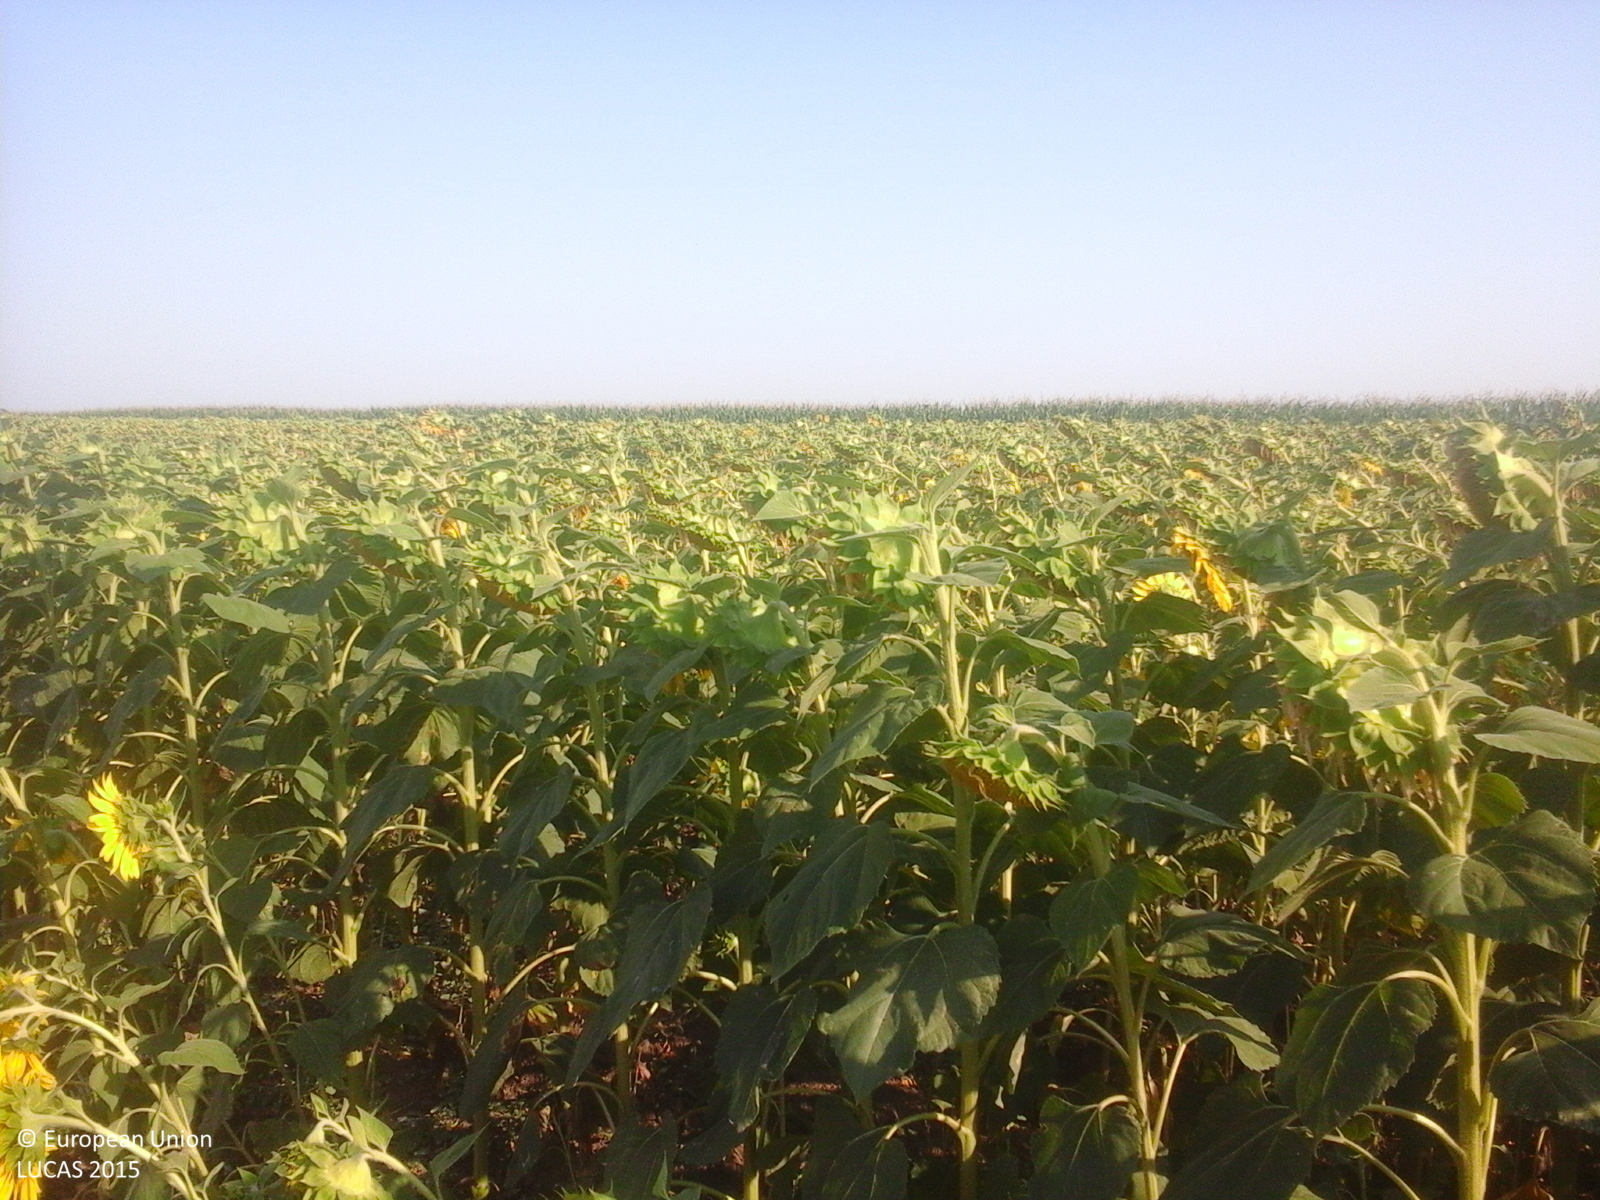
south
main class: Cropland
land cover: Sunflower
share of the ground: > 75 %
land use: Agriculture (excluding fallow land and kitchen gardens)
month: July
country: RO
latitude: 44.9461
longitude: 27.7336
